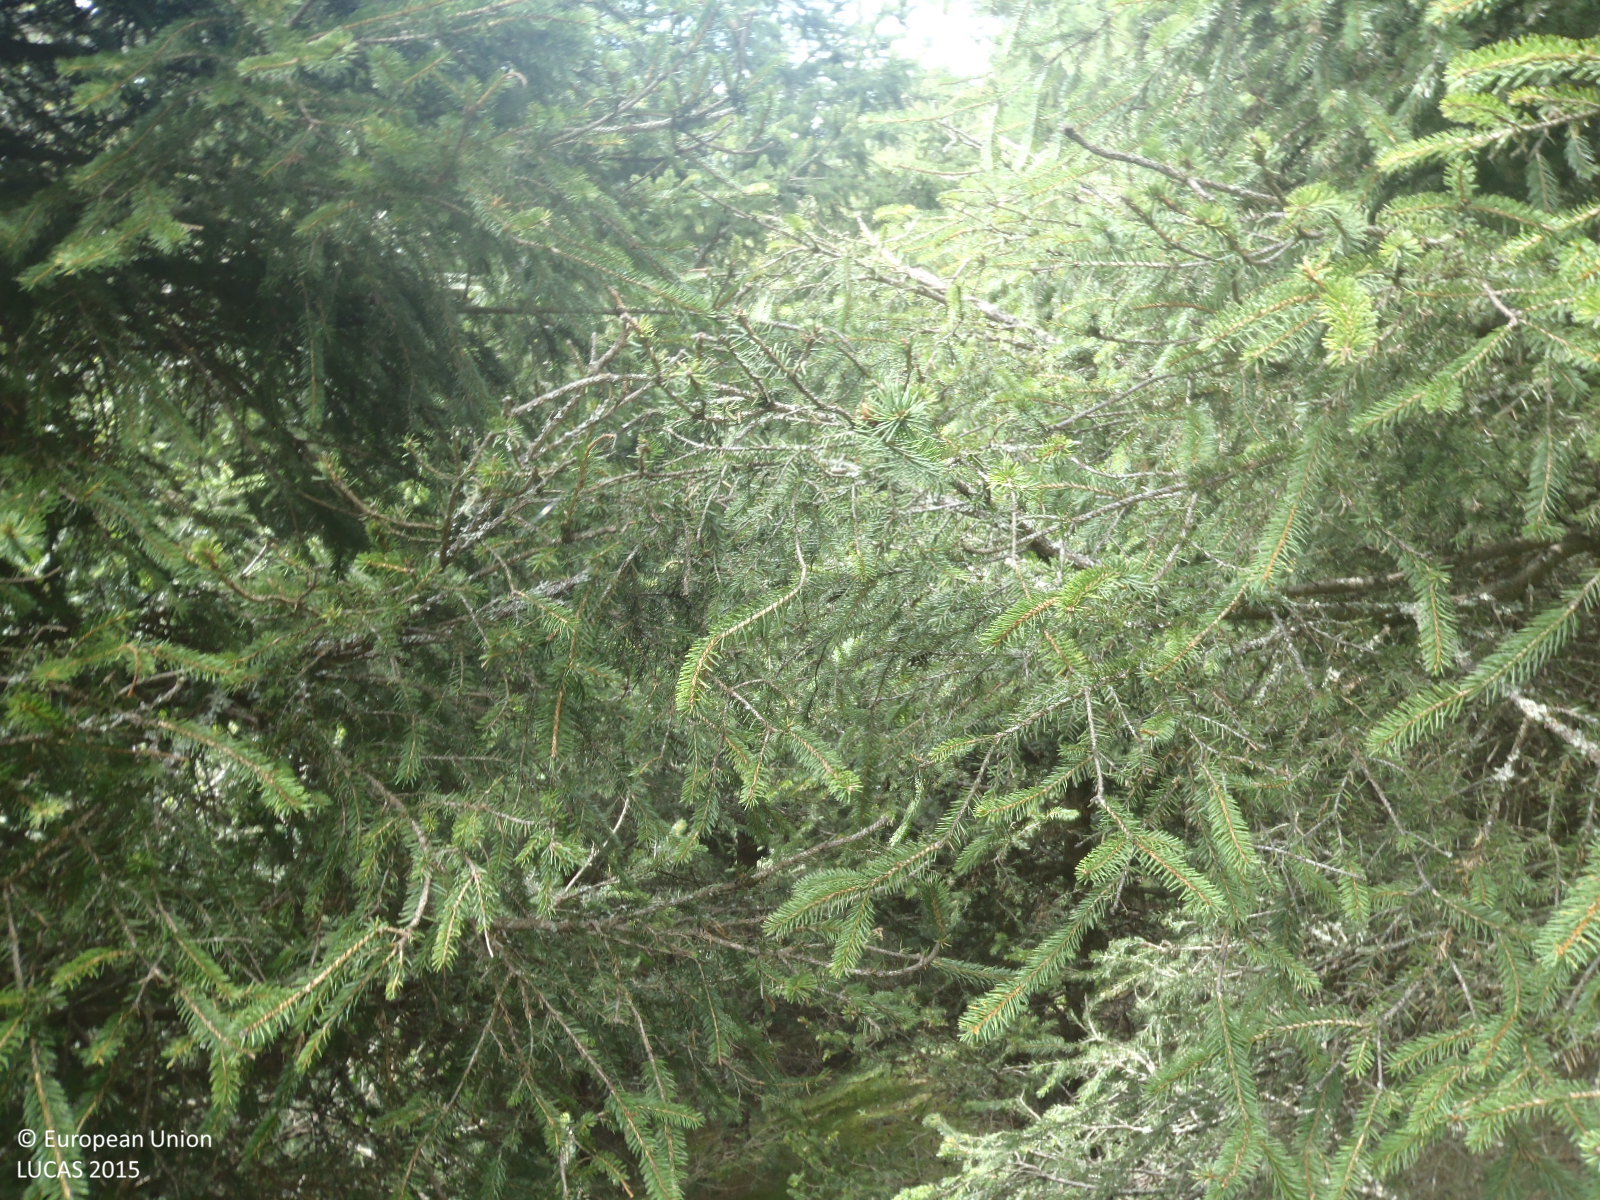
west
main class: Woodland
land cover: Spruce dominated coniferous woodland
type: alpine coniferous forest
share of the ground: > 75 %
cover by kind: coniferous forest trees 90 %, herbaceous plants 10 %
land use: Forestry
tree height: > 5 m
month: August
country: AT
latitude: 46.9200
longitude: 12.3484
